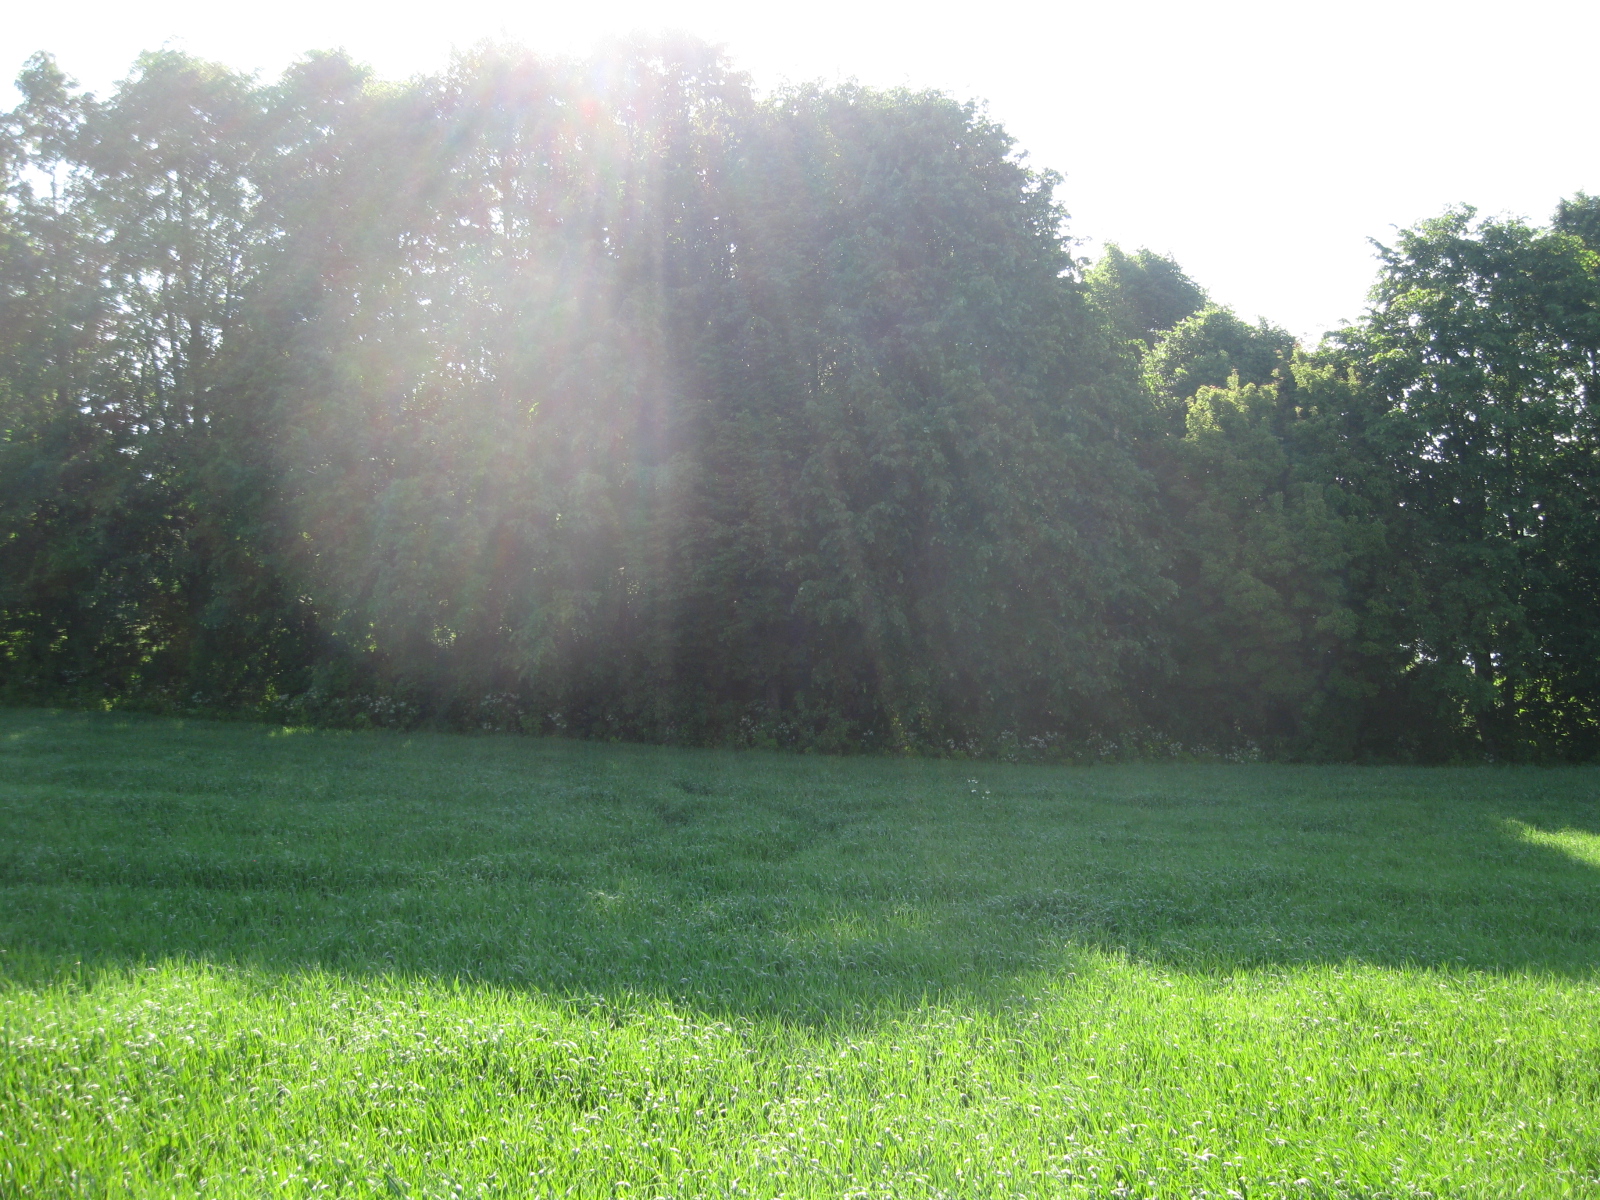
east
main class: Cropland
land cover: Barley
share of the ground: > 75 %
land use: Agriculture (excluding fallow land and kitchen gardens)
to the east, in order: Barley; Broadleaved woodland; Fences; Broadleaved woodland; Fences; Broadleaved woodland; Inland fresh water bodies; Artificial constructions in urban areas
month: June
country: LT
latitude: 55.4169
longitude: 23.6523
